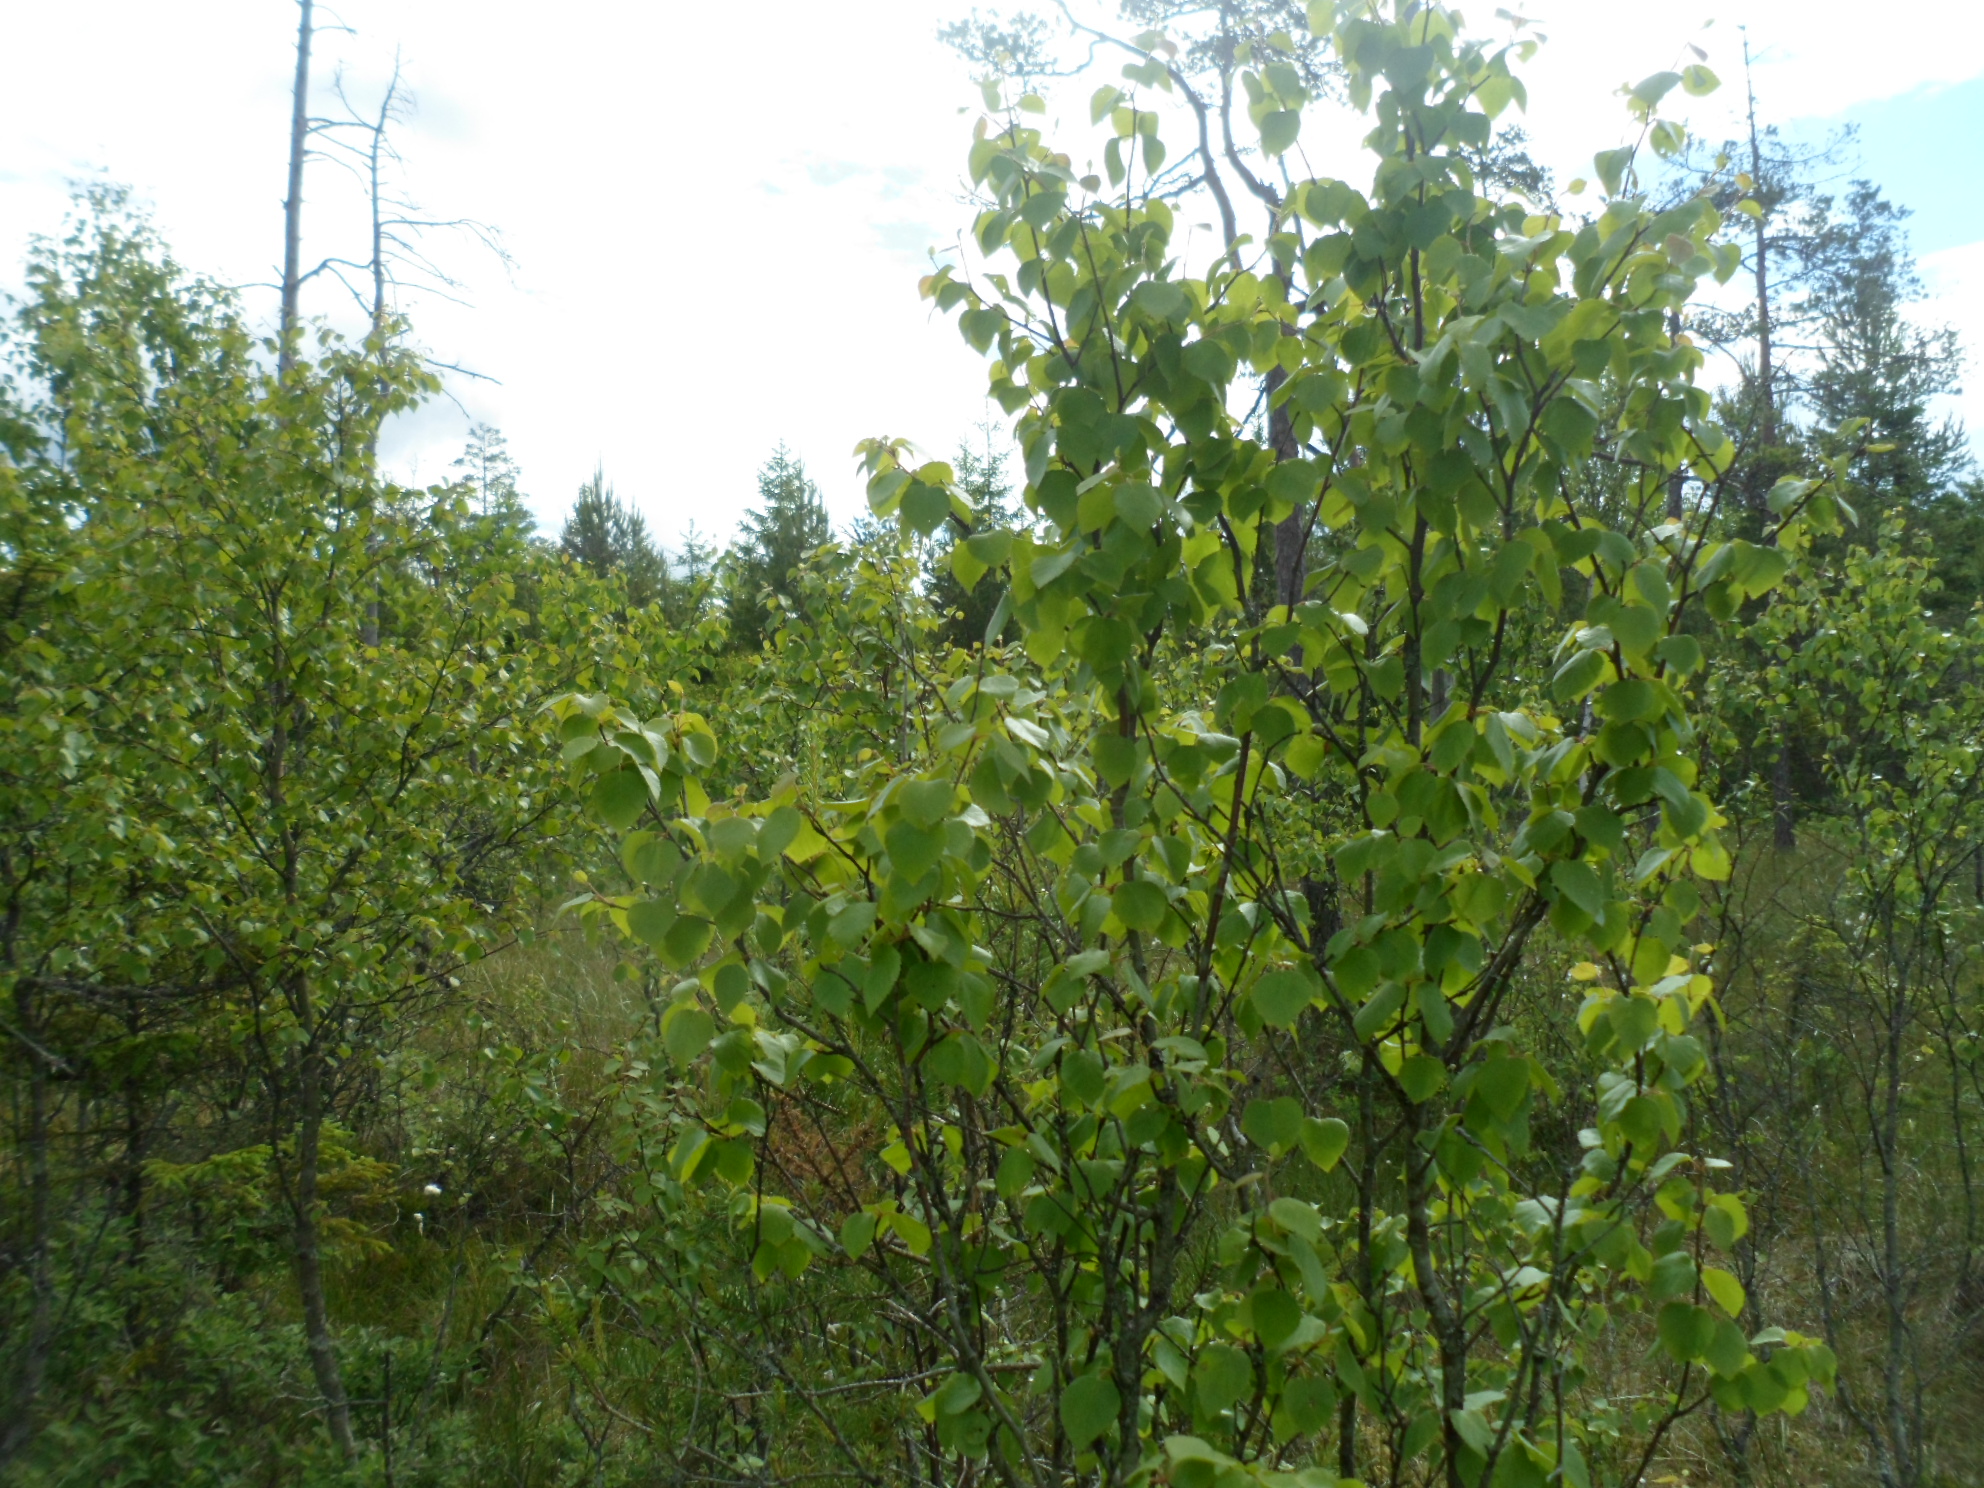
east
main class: Woodland
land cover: Pine dominated mixed woodland
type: boreal forest
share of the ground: 25 - 50 %
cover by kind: lichens and mosses 30 %, coniferous forest trees 20 %, broadleaved forest trees 20 %, shrubs 20 %, herbaceous plants 10 %
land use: Forestry
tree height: > 5 m
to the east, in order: Pine dominated mixed woodland; Pine dominated coniferous woodland; Grassland with sparse tree/shrub cover; Pine dominated coniferous woodland
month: June
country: SE
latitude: 56.9721
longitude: 15.4759
